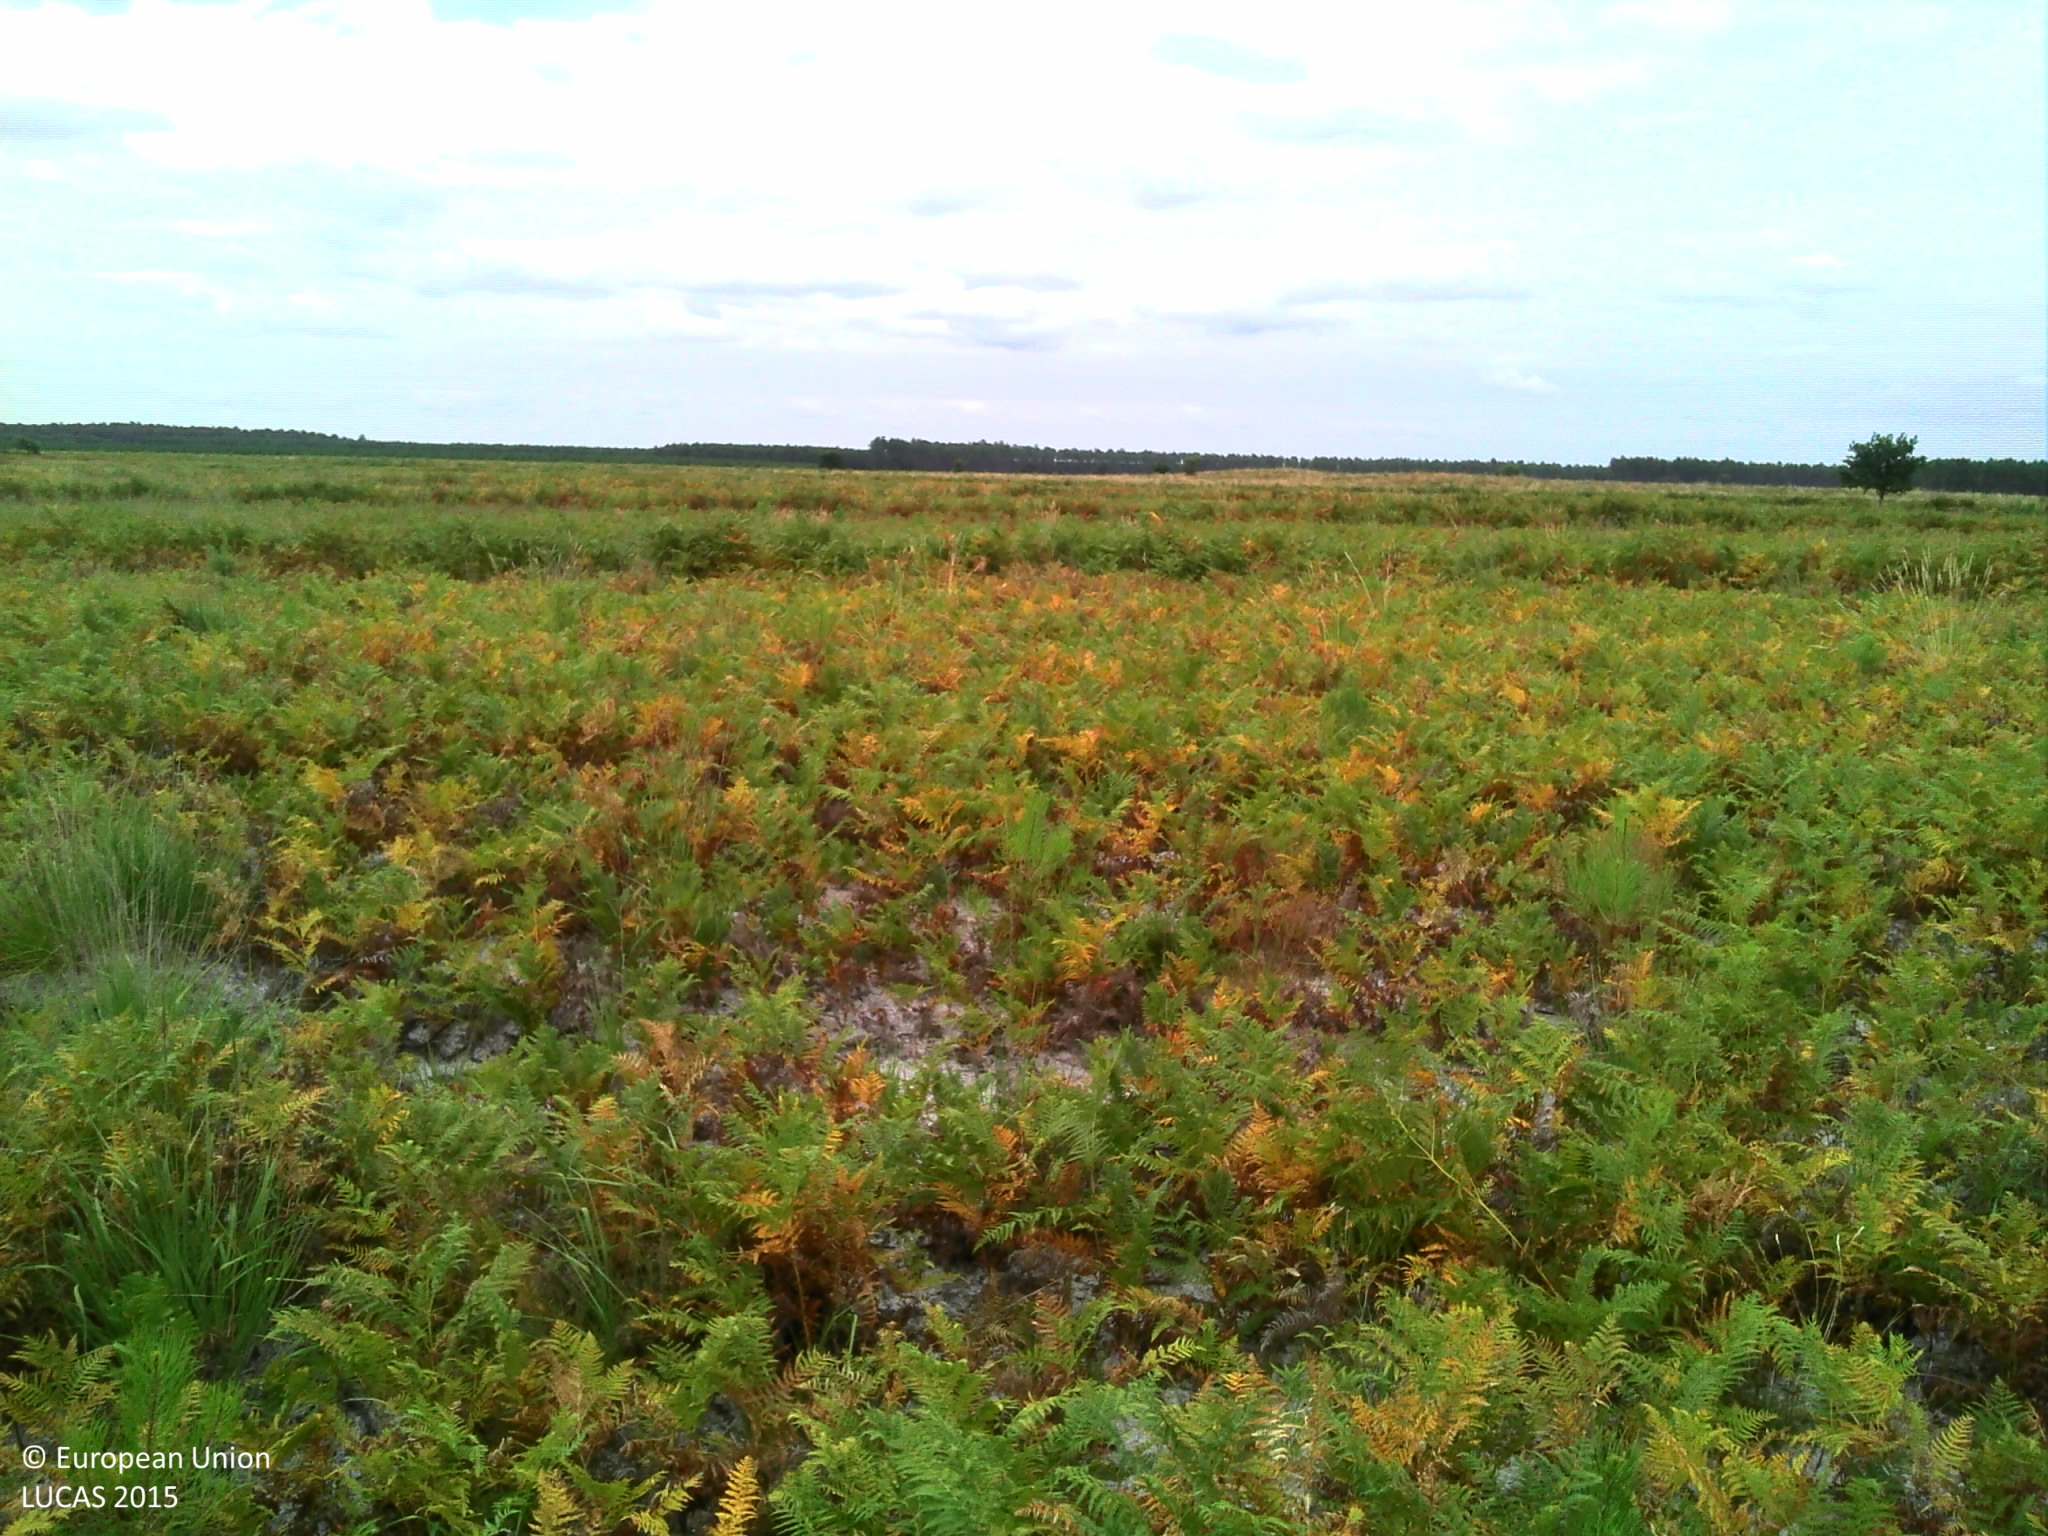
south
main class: Grassland
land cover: Spontaneously vegetated surfaces
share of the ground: > 75 %
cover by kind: herbaceous plants 95 %, shrubs 5 %
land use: Forestry
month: July
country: FR
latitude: 44.2646
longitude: -1.0809
